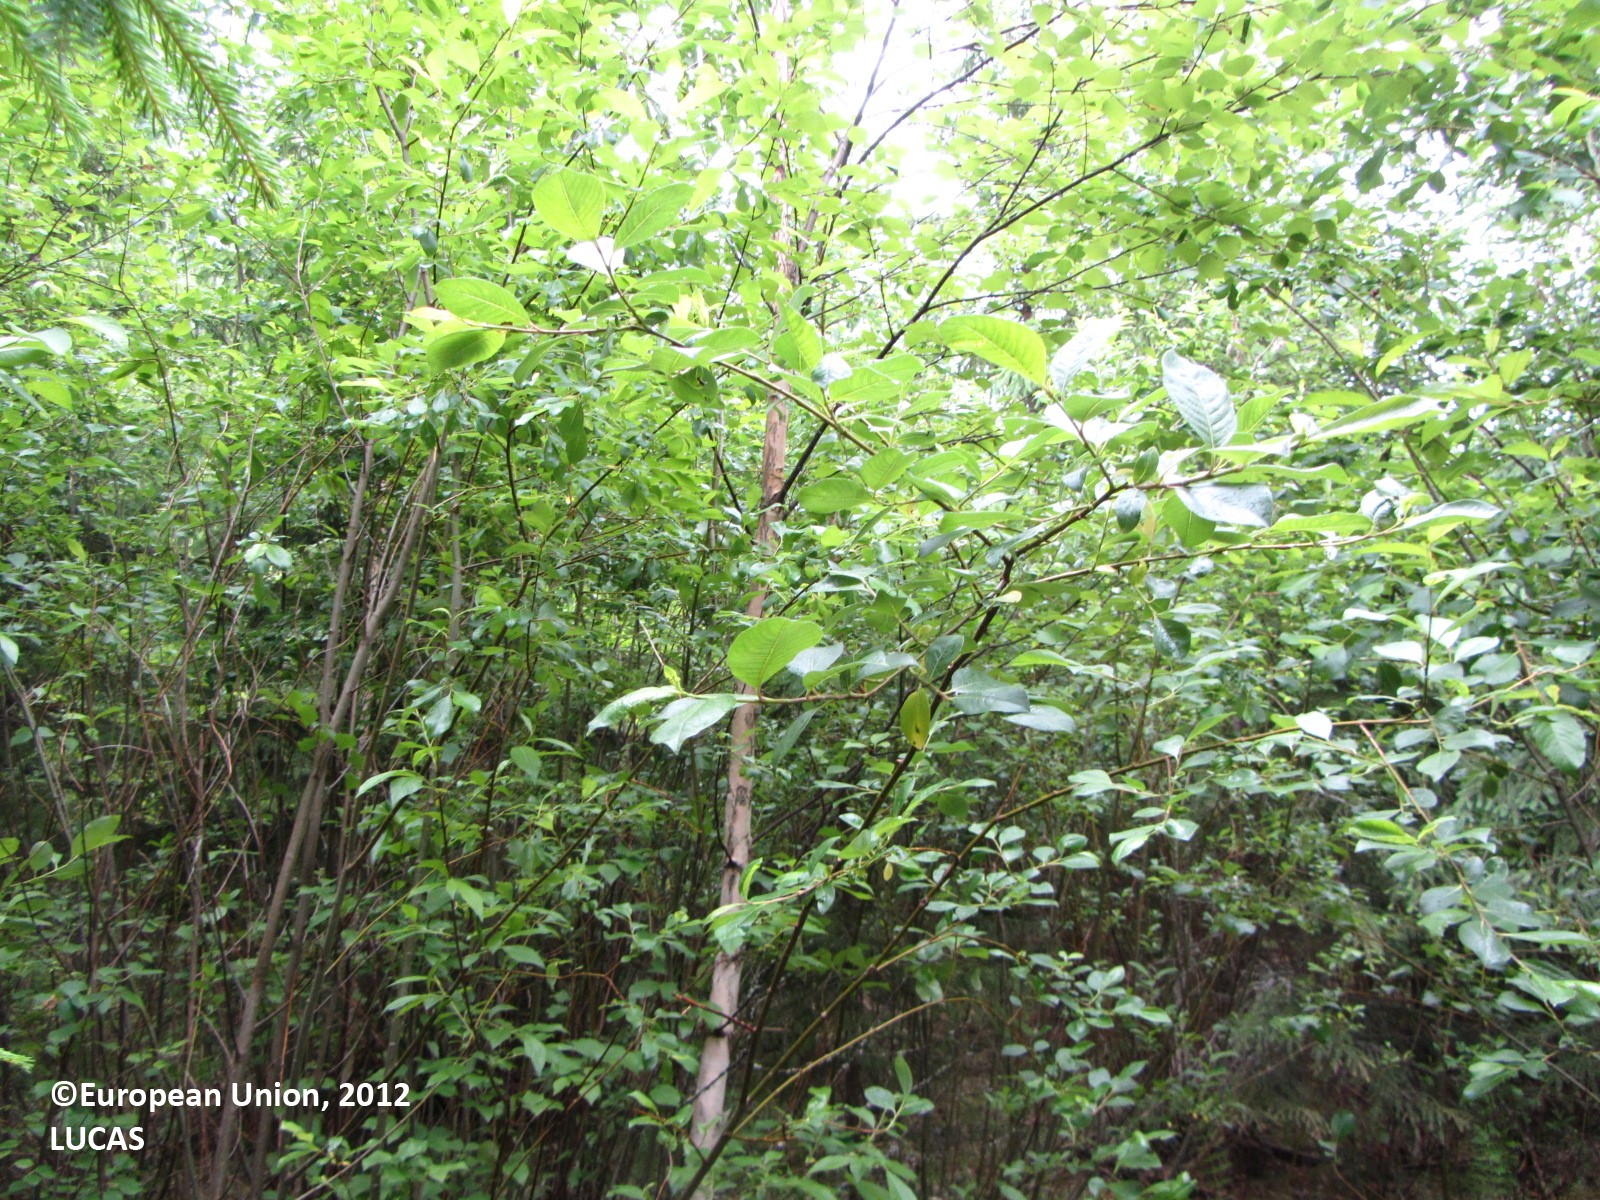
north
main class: Woodland
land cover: Spruce dominated mixed woodland
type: boreal forest
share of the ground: > 75 %
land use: Forestry
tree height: > 5 m
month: June
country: FI
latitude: 62.6211
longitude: 25.6090
